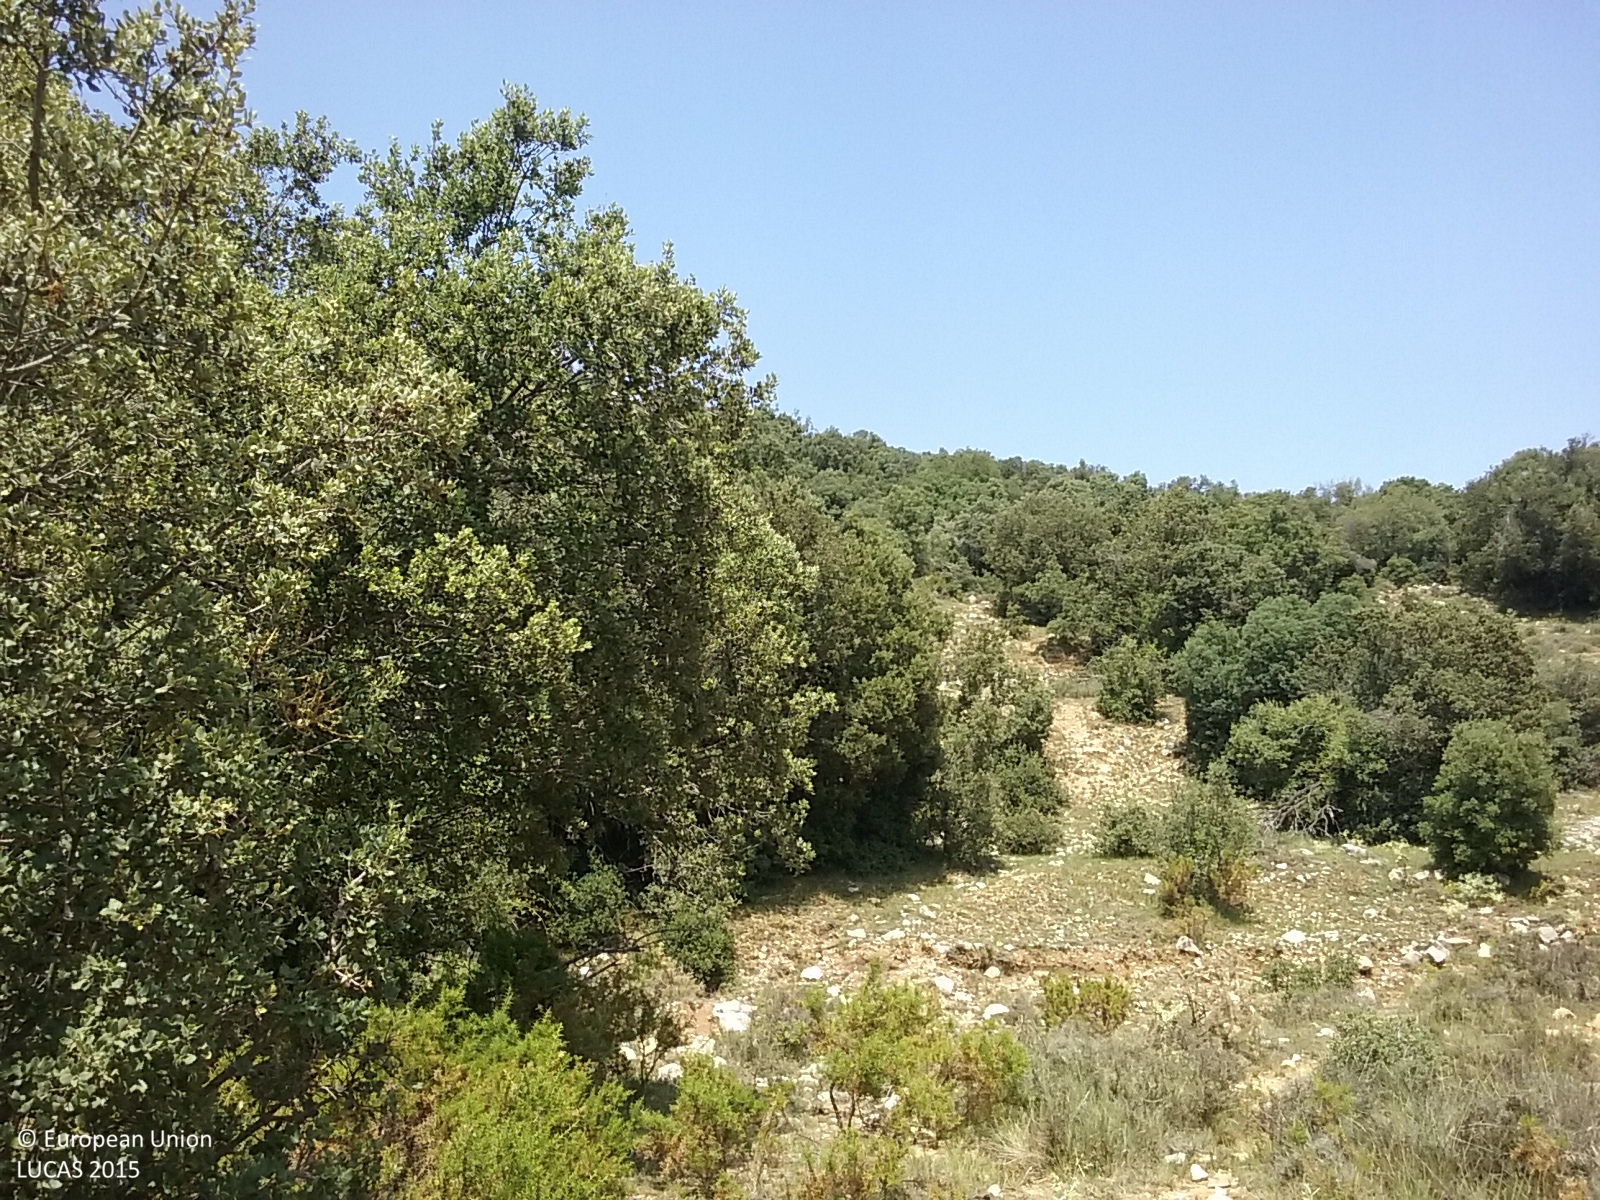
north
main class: Woodland
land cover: Broadleaved woodland
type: broadleaved evergreen forest
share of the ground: 50 - 75 %
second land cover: Shrubland without tree cover
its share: 25 - 50 %
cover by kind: broadleaved forest trees 60 %, shrubs 20 %, herbaceous plants 20 %
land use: Forestry
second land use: Agriculture (excluding fallow land and kitchen gardens)
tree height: > 5 m
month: August
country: ES
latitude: 40.4183
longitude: -0.1056
